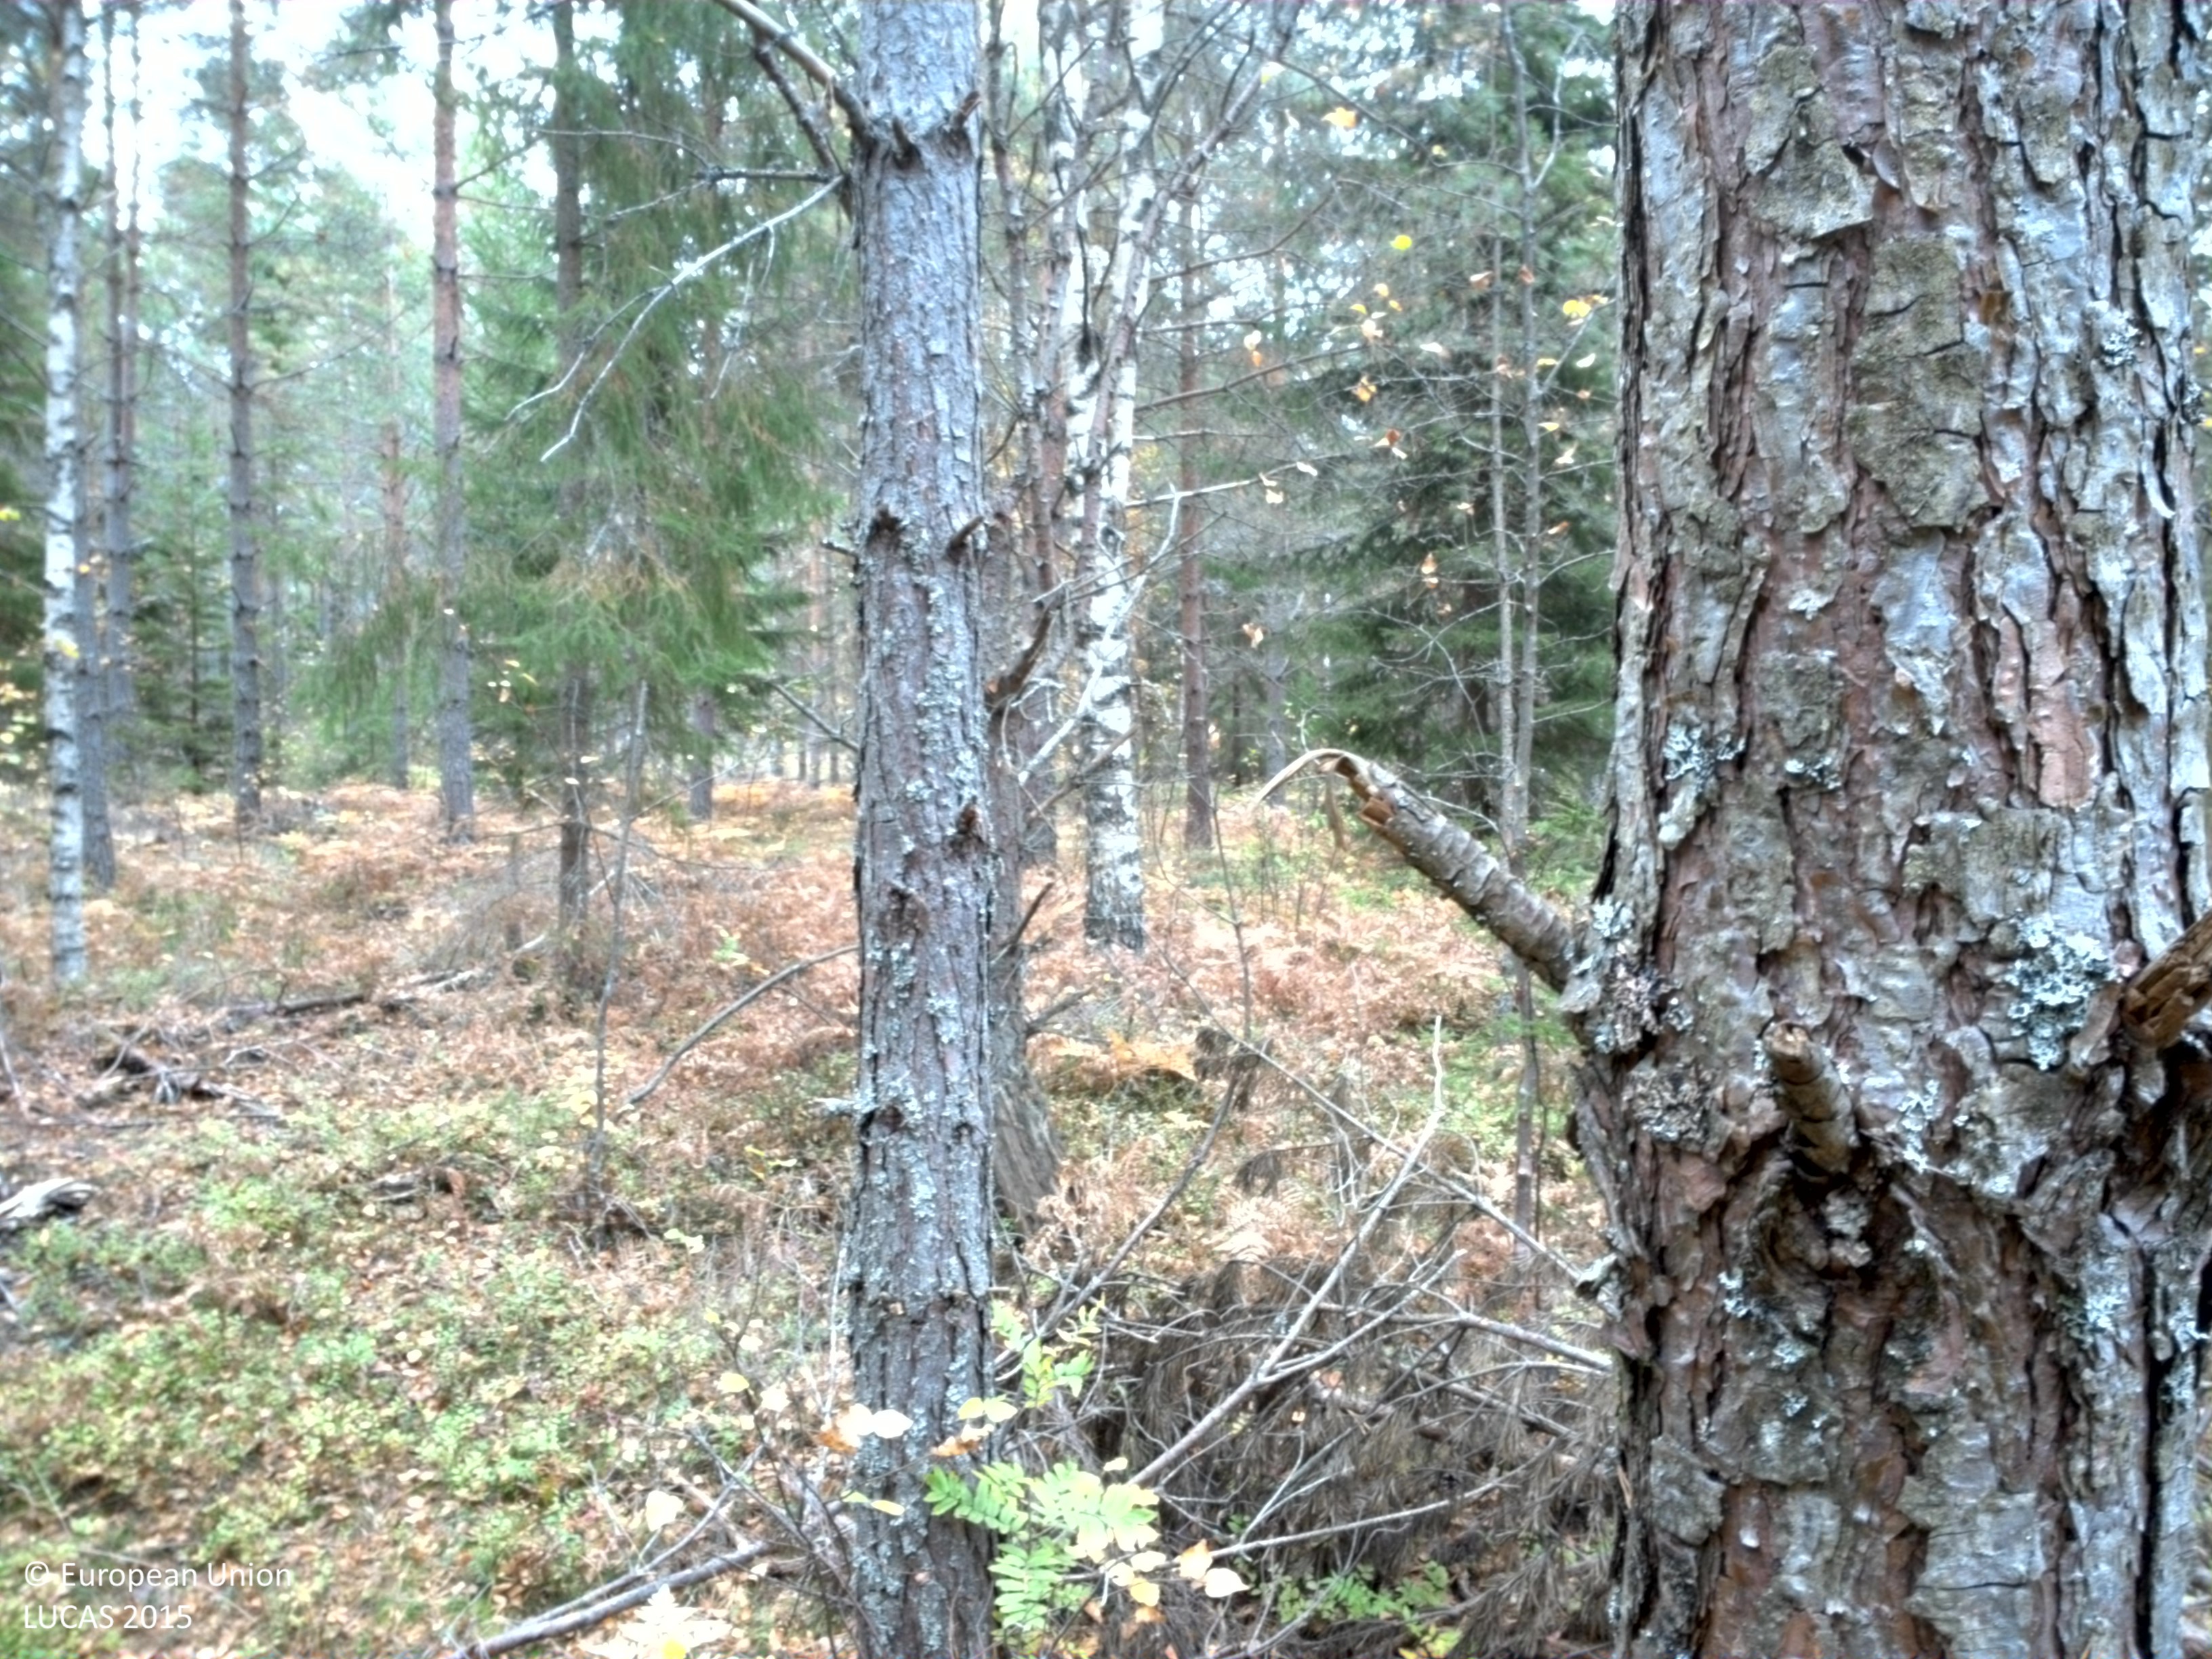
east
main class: Woodland
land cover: Pine dominated mixed woodland
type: boreal forest
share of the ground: 25 - 50 %
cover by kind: shrubs 30 %, lichens and mosses 25 %, coniferous forest trees 20 %, broadleaved forest trees 15 %, herbaceous plants 10 %
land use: Forestry
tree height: > 5 m
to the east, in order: Pine dominated mixed woodland; Other coniferous woodland; Spruce dominated mixed woodland
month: October
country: SE
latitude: 59.0492
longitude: 13.0441
